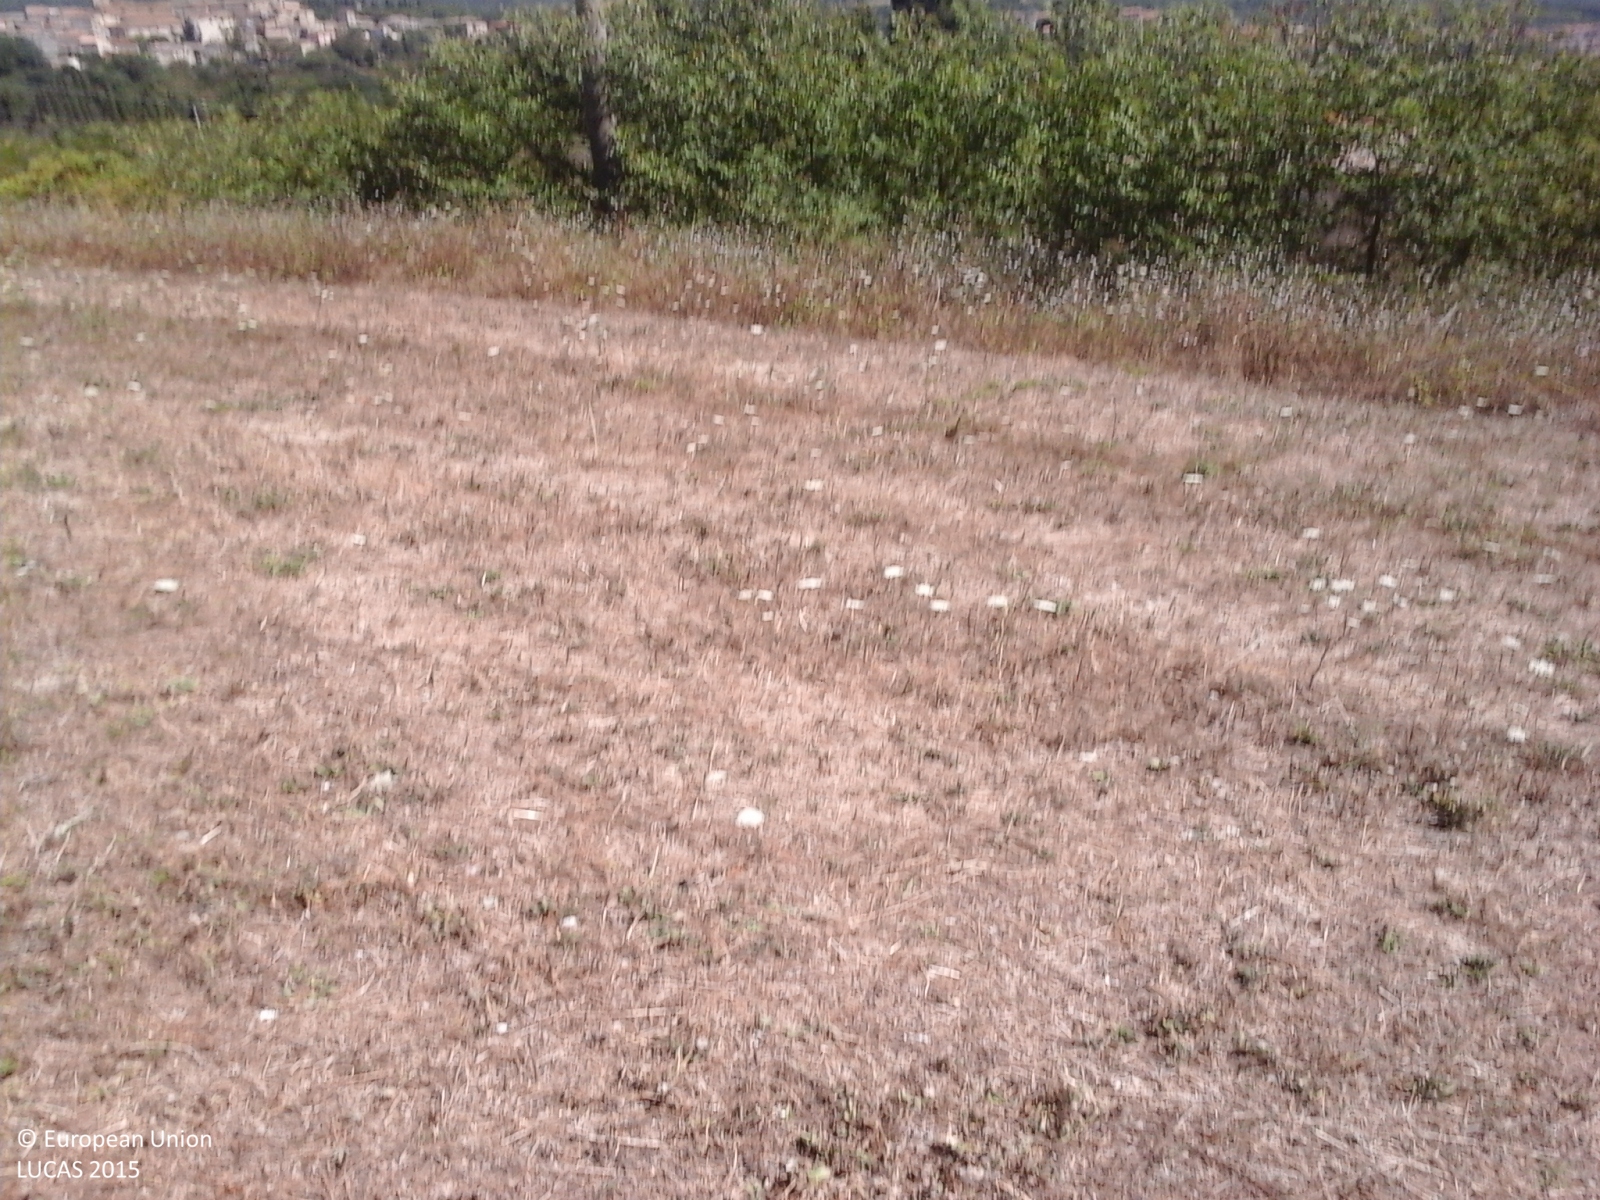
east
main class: Cropland
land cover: Temporary grasslands
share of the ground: 25 - 50 %
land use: Agriculture (excluding fallow land and kitchen gardens)
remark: Harvested field
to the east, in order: Temporary grasslands; Electric lines; Grass margins; Tracks; Fences; Grassland without tree/shrub cover; Fences; Tracks; Abandoned hedges; Durum wheat; Abandoned hedges; Lucerne; Electric lines; Lucerne
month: August
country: IT
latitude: 42.8717
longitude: 11.8671
